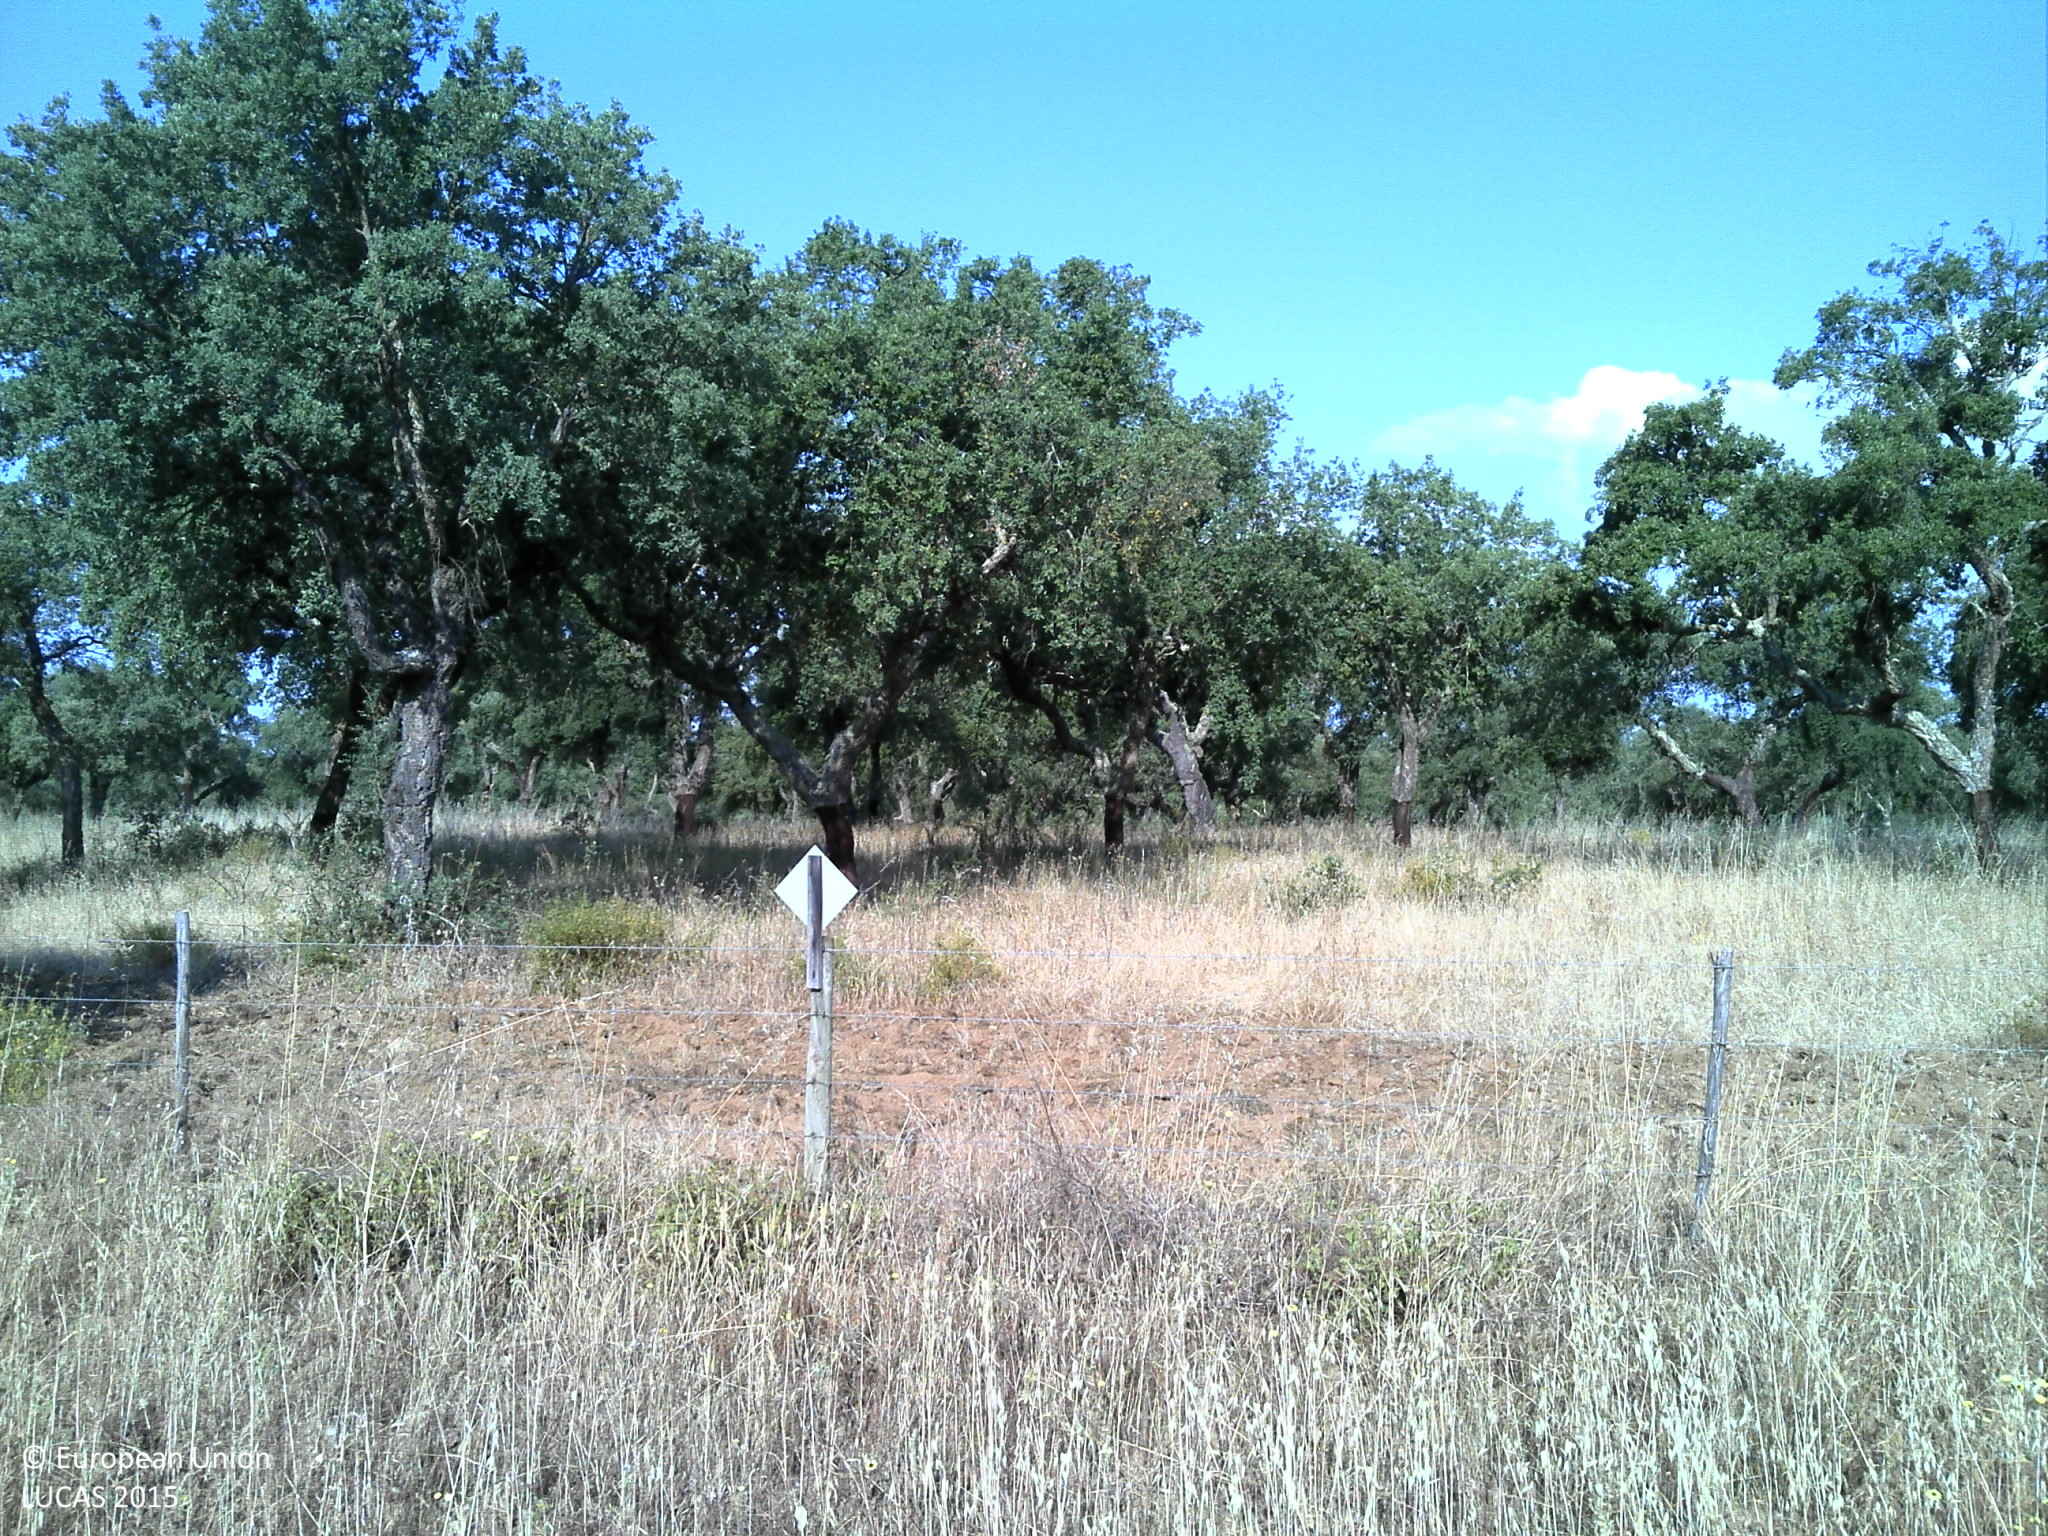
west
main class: Woodland
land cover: Broadleaved woodland
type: broadleaved evergreen forest
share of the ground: 25 - 50 %
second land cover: Oats
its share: 50 - 75 %
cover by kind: herbaceous plants 60 %, broadleaved forest trees 30 %, unconsolidated bare surface 10 %
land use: Forestry
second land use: Agriculture (excluding fallow land and kitchen gardens)
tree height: > 5 m
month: May
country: PT
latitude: 38.9173
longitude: -7.8166
